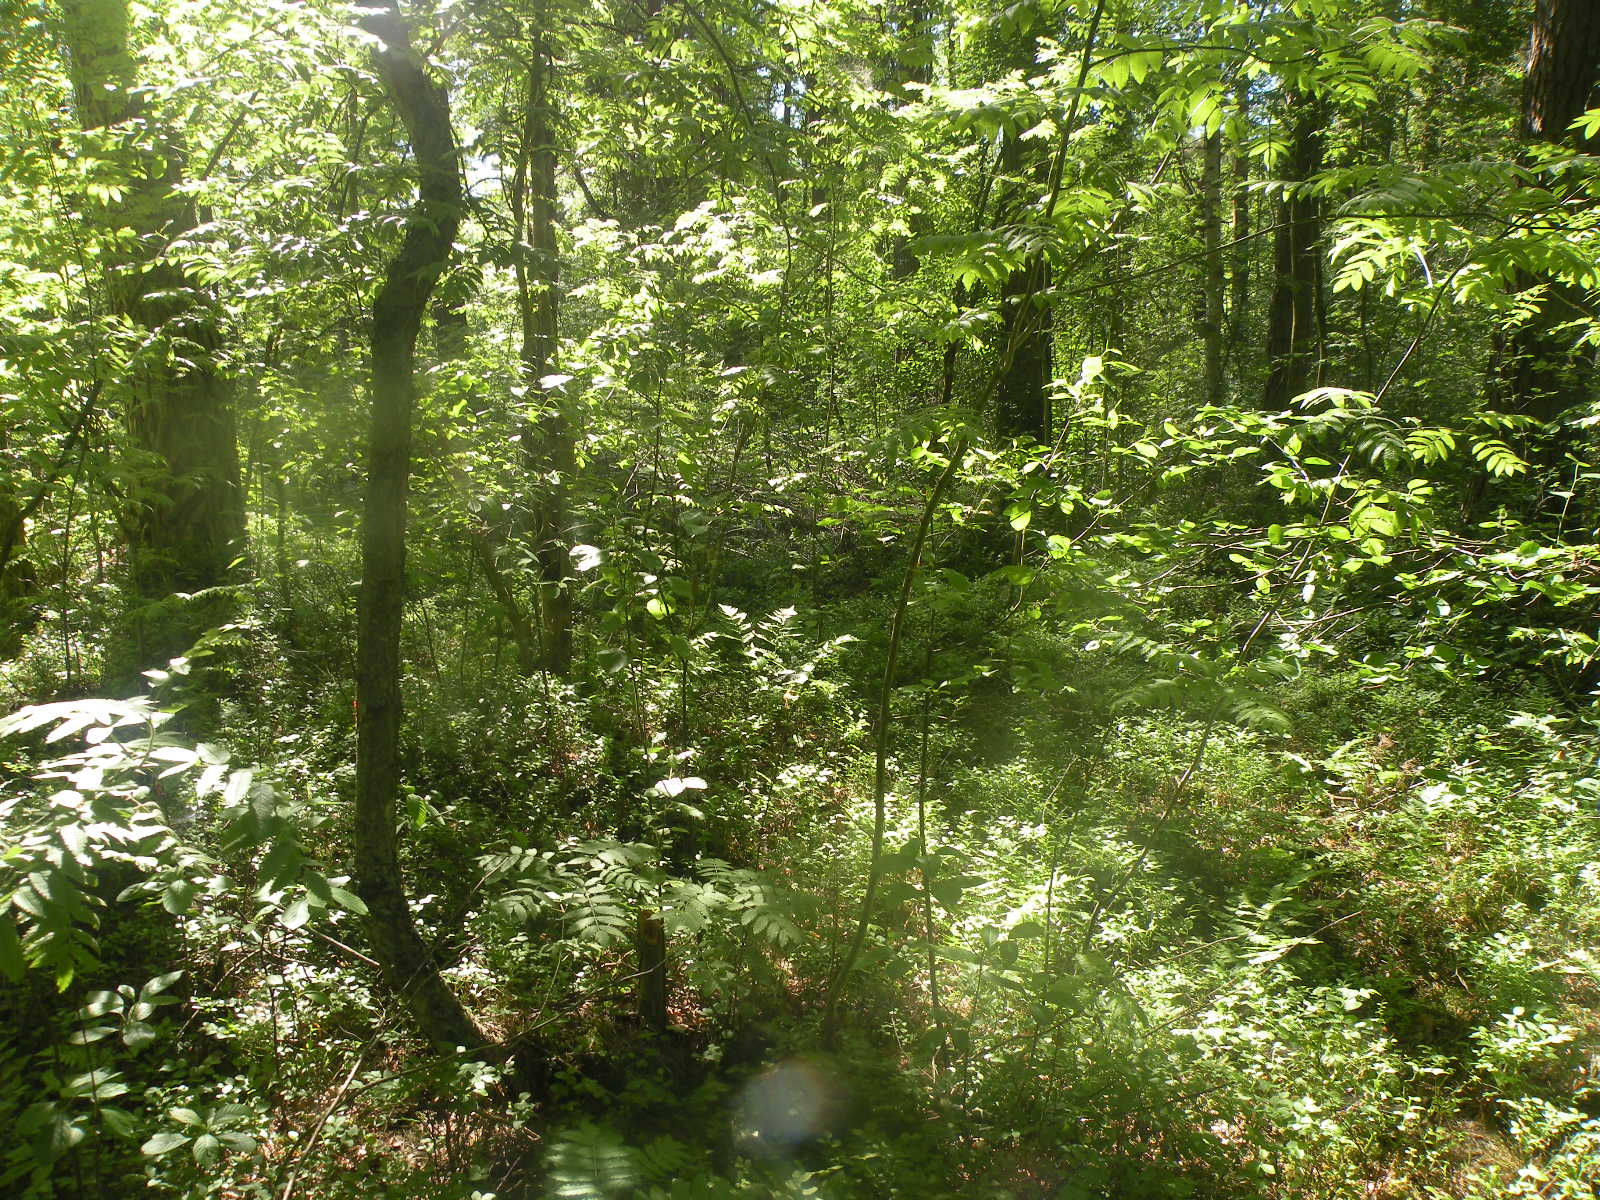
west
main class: Woodland
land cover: Pine dominated mixed woodland
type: hemiboreal forest and nemoral coniferous forest and mixed broadleaved-coniferous forest
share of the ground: > 75 %
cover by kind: coniferous forest trees 55 %, broadleaved forest trees 25 %, shrubs 10 %, herbaceous plants 10 %
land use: Forestry
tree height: > 5 m
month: June
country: LV
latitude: 55.8857
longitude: 26.6049
